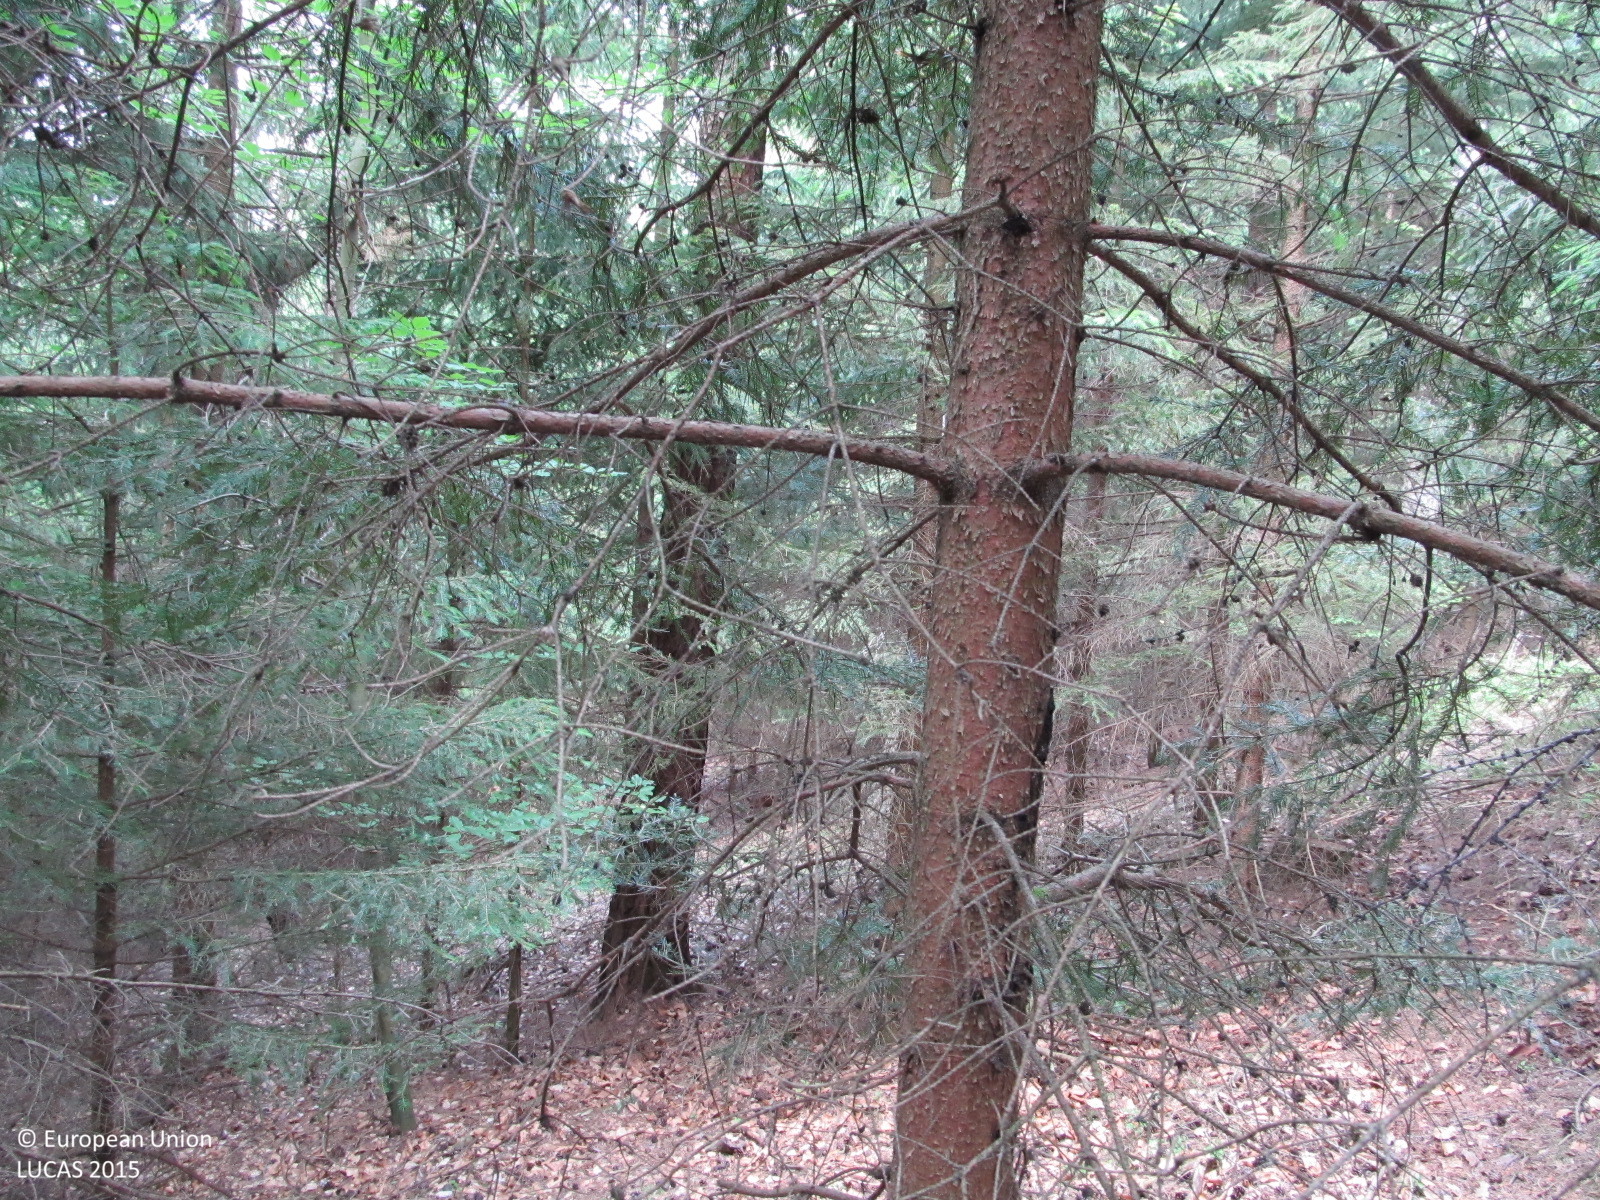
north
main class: Woodland
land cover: Spruce dominated coniferous woodland
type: hemiboreal forest and nemoral coniferous forest and mixed broadleaved-coniferous forest
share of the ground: > 75 %
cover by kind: coniferous forest trees 85 %, unconsolidated bare surface 10 %, broadleaved forest trees 5 %
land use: Forestry
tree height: > 5 m
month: June
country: AT
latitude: 48.4301
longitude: 15.4762
